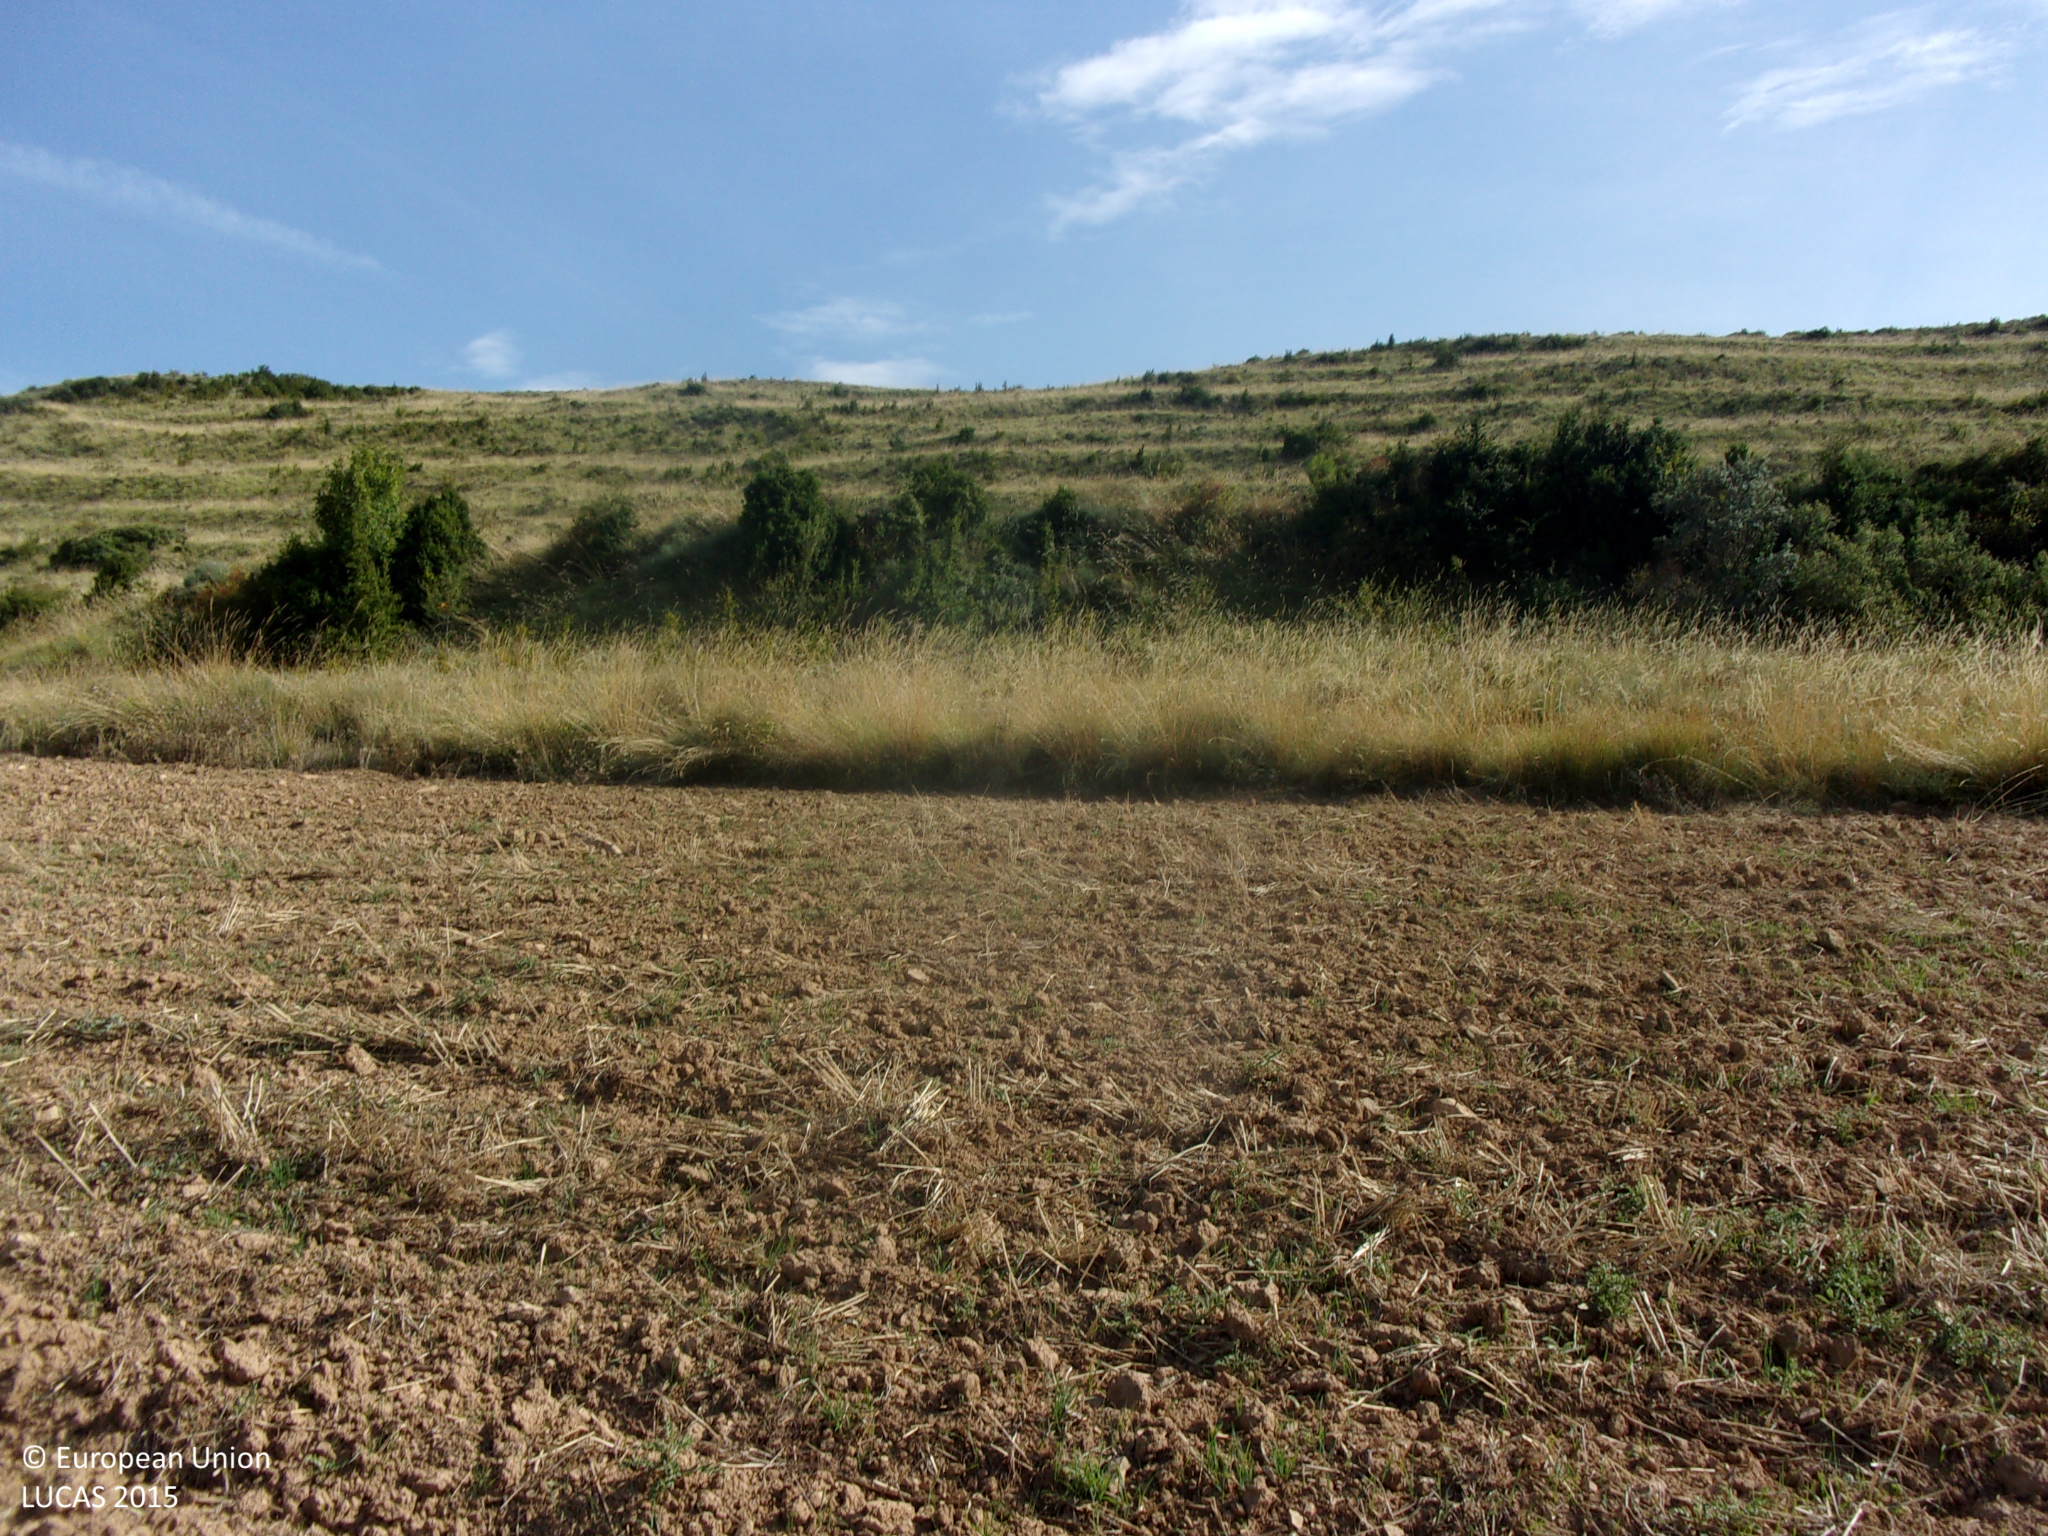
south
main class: Cropland
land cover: Common wheat
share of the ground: < 10 %
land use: Agriculture (excluding fallow land and kitchen gardens)
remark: Harvested field
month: August
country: ES
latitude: 42.5053
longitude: -1.1915
